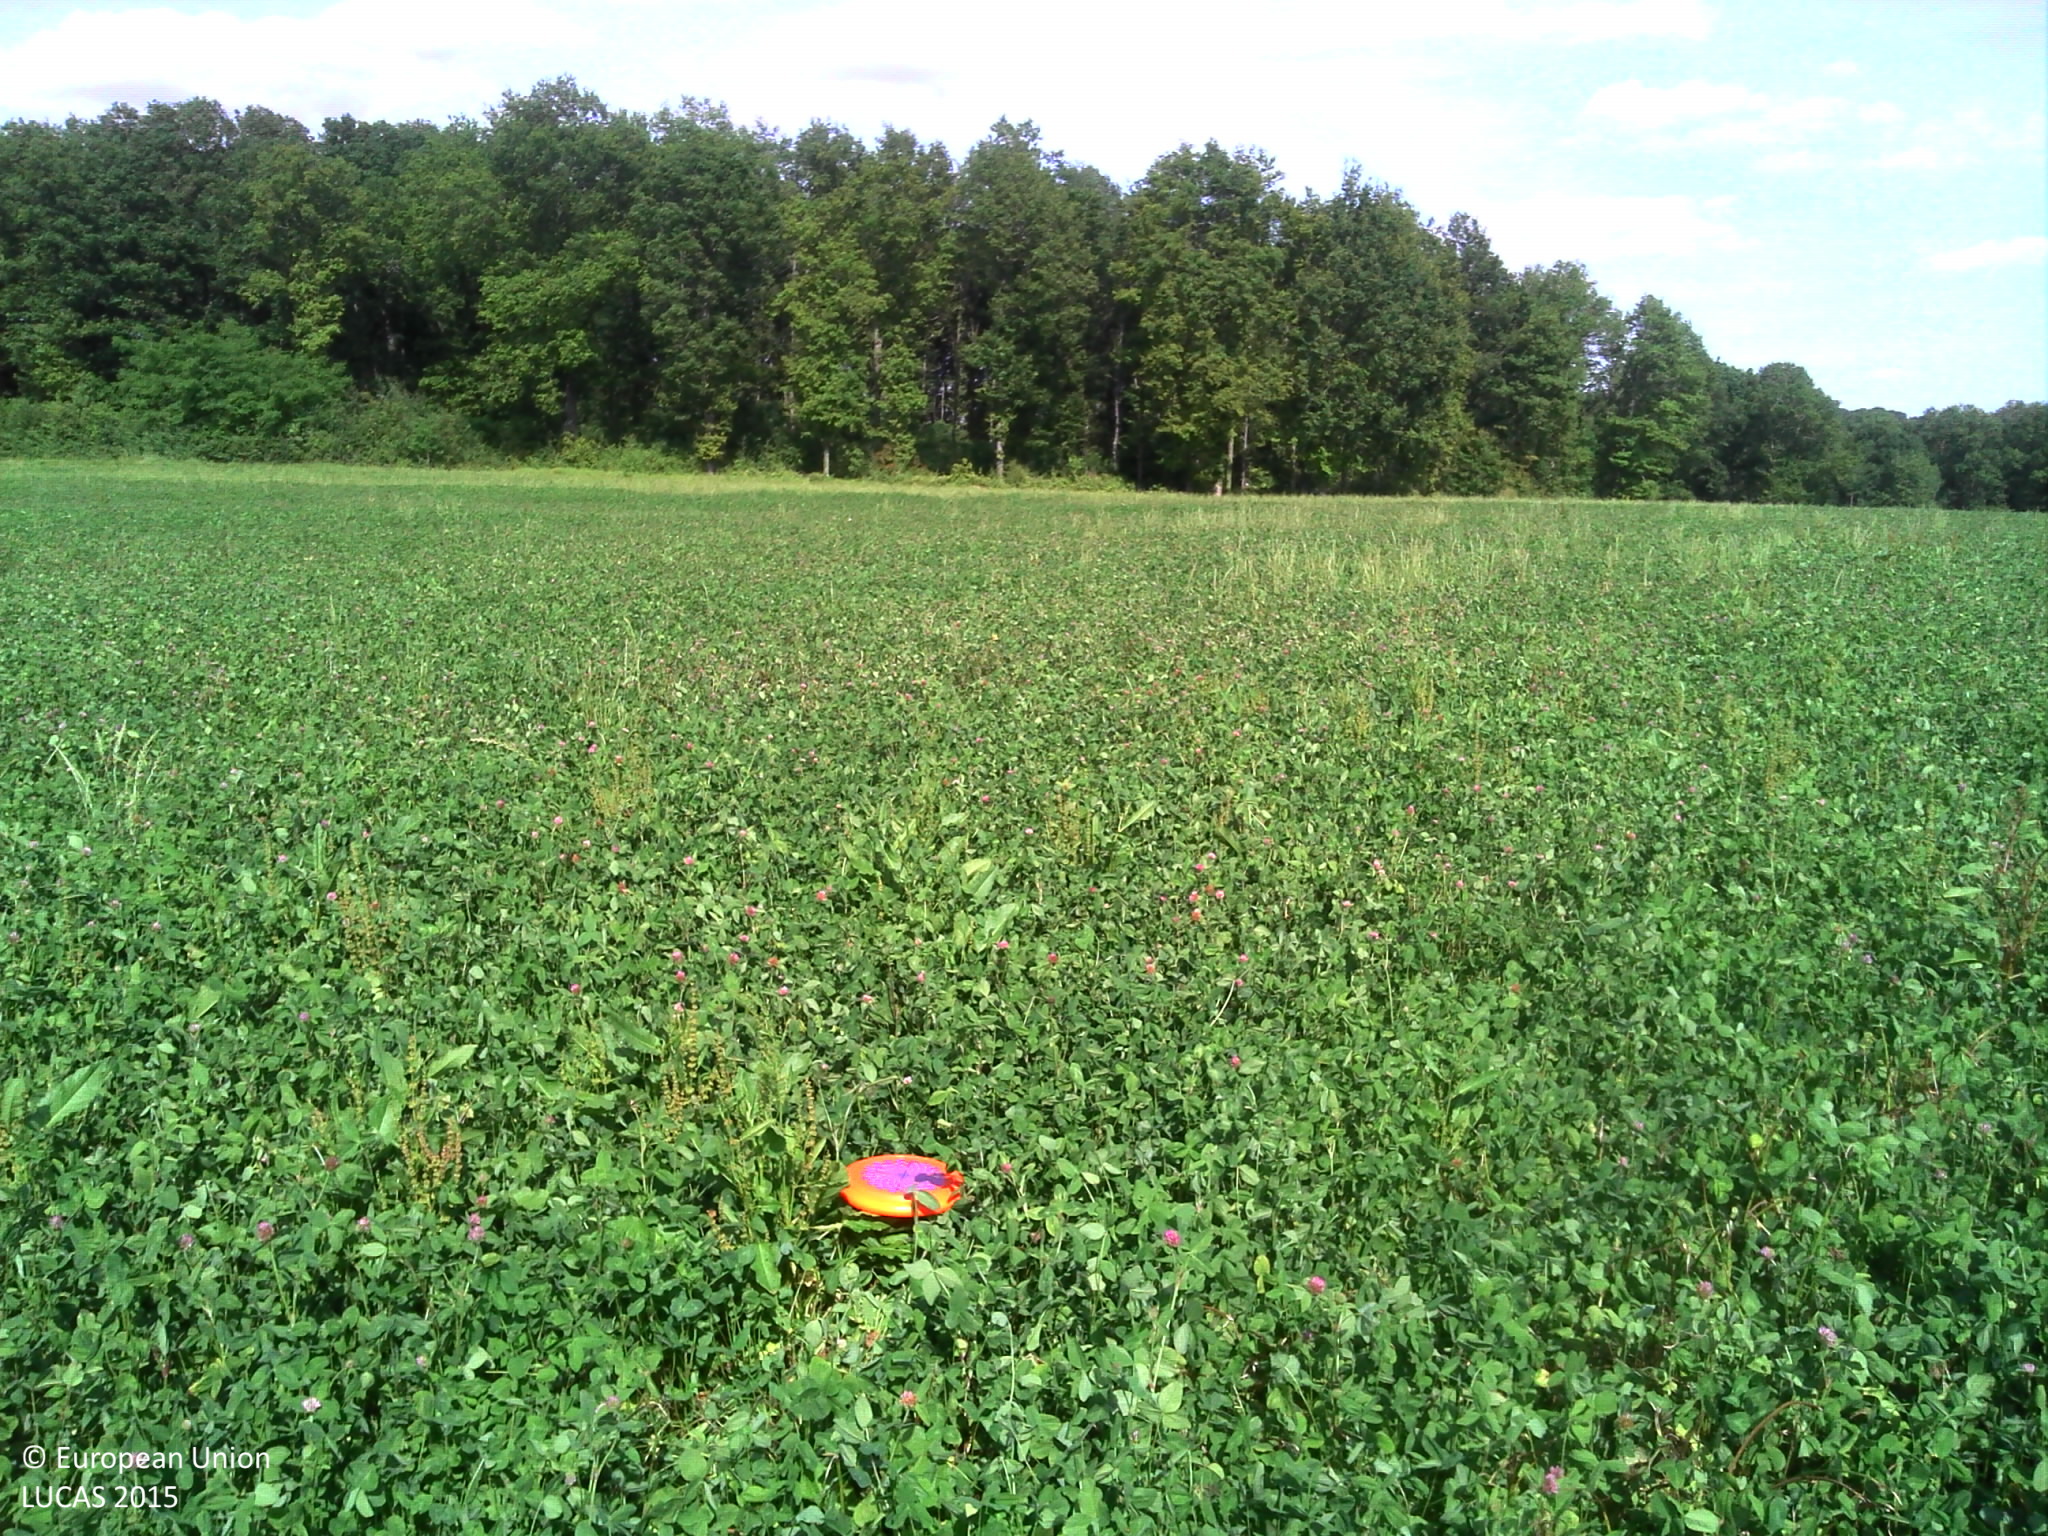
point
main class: Cropland
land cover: Clovers
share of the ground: > 75 %
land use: Agriculture (excluding fallow land and kitchen gardens)
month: June
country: FR
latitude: 48.0996
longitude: 3.4280
